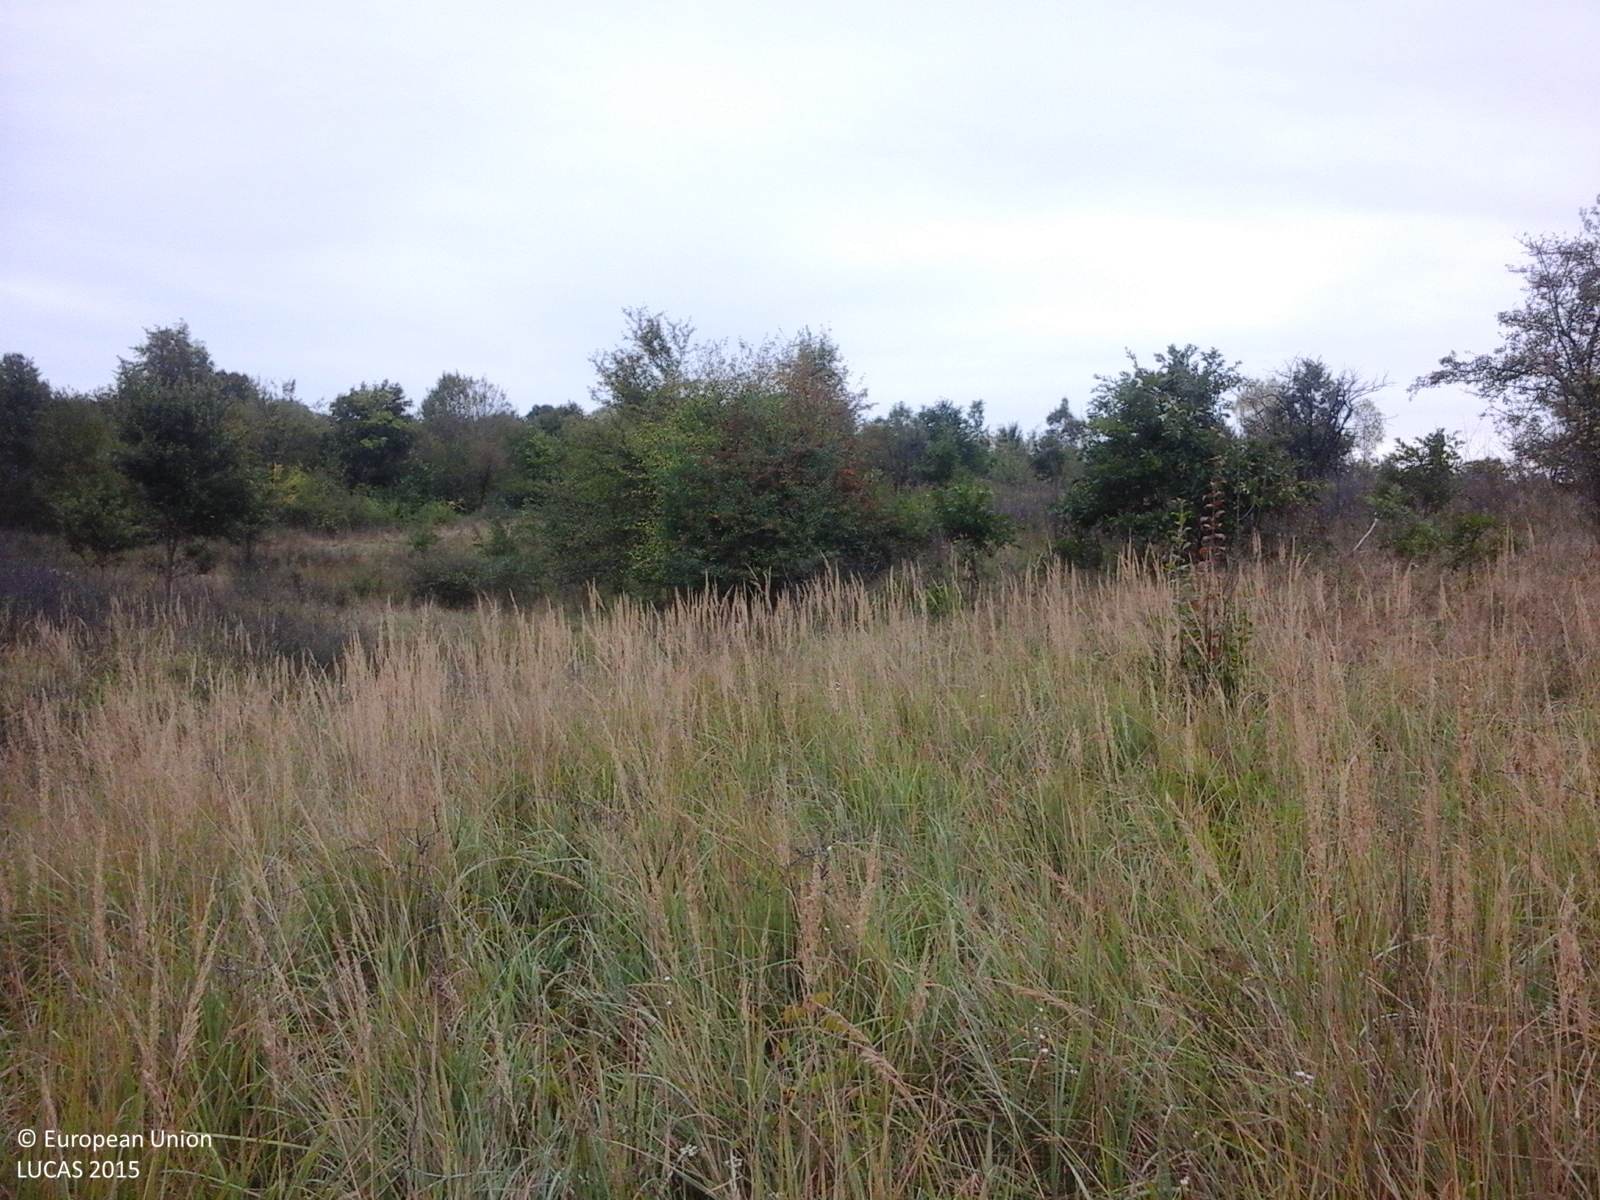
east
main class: Grassland
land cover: Spontaneously vegetated surfaces
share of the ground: > 75 %
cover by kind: herbaceous plants 100 %
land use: Fallow land
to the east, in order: Spontaneously vegetated surfaces; Shrubland with sparse tree cover; Grassland with sparse tree/shrub cover; Tracks; Broadleaved woodland; Tracks; Grassland with sparse tree/shrub cover
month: September
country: RO
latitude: 45.9552
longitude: 22.2369
